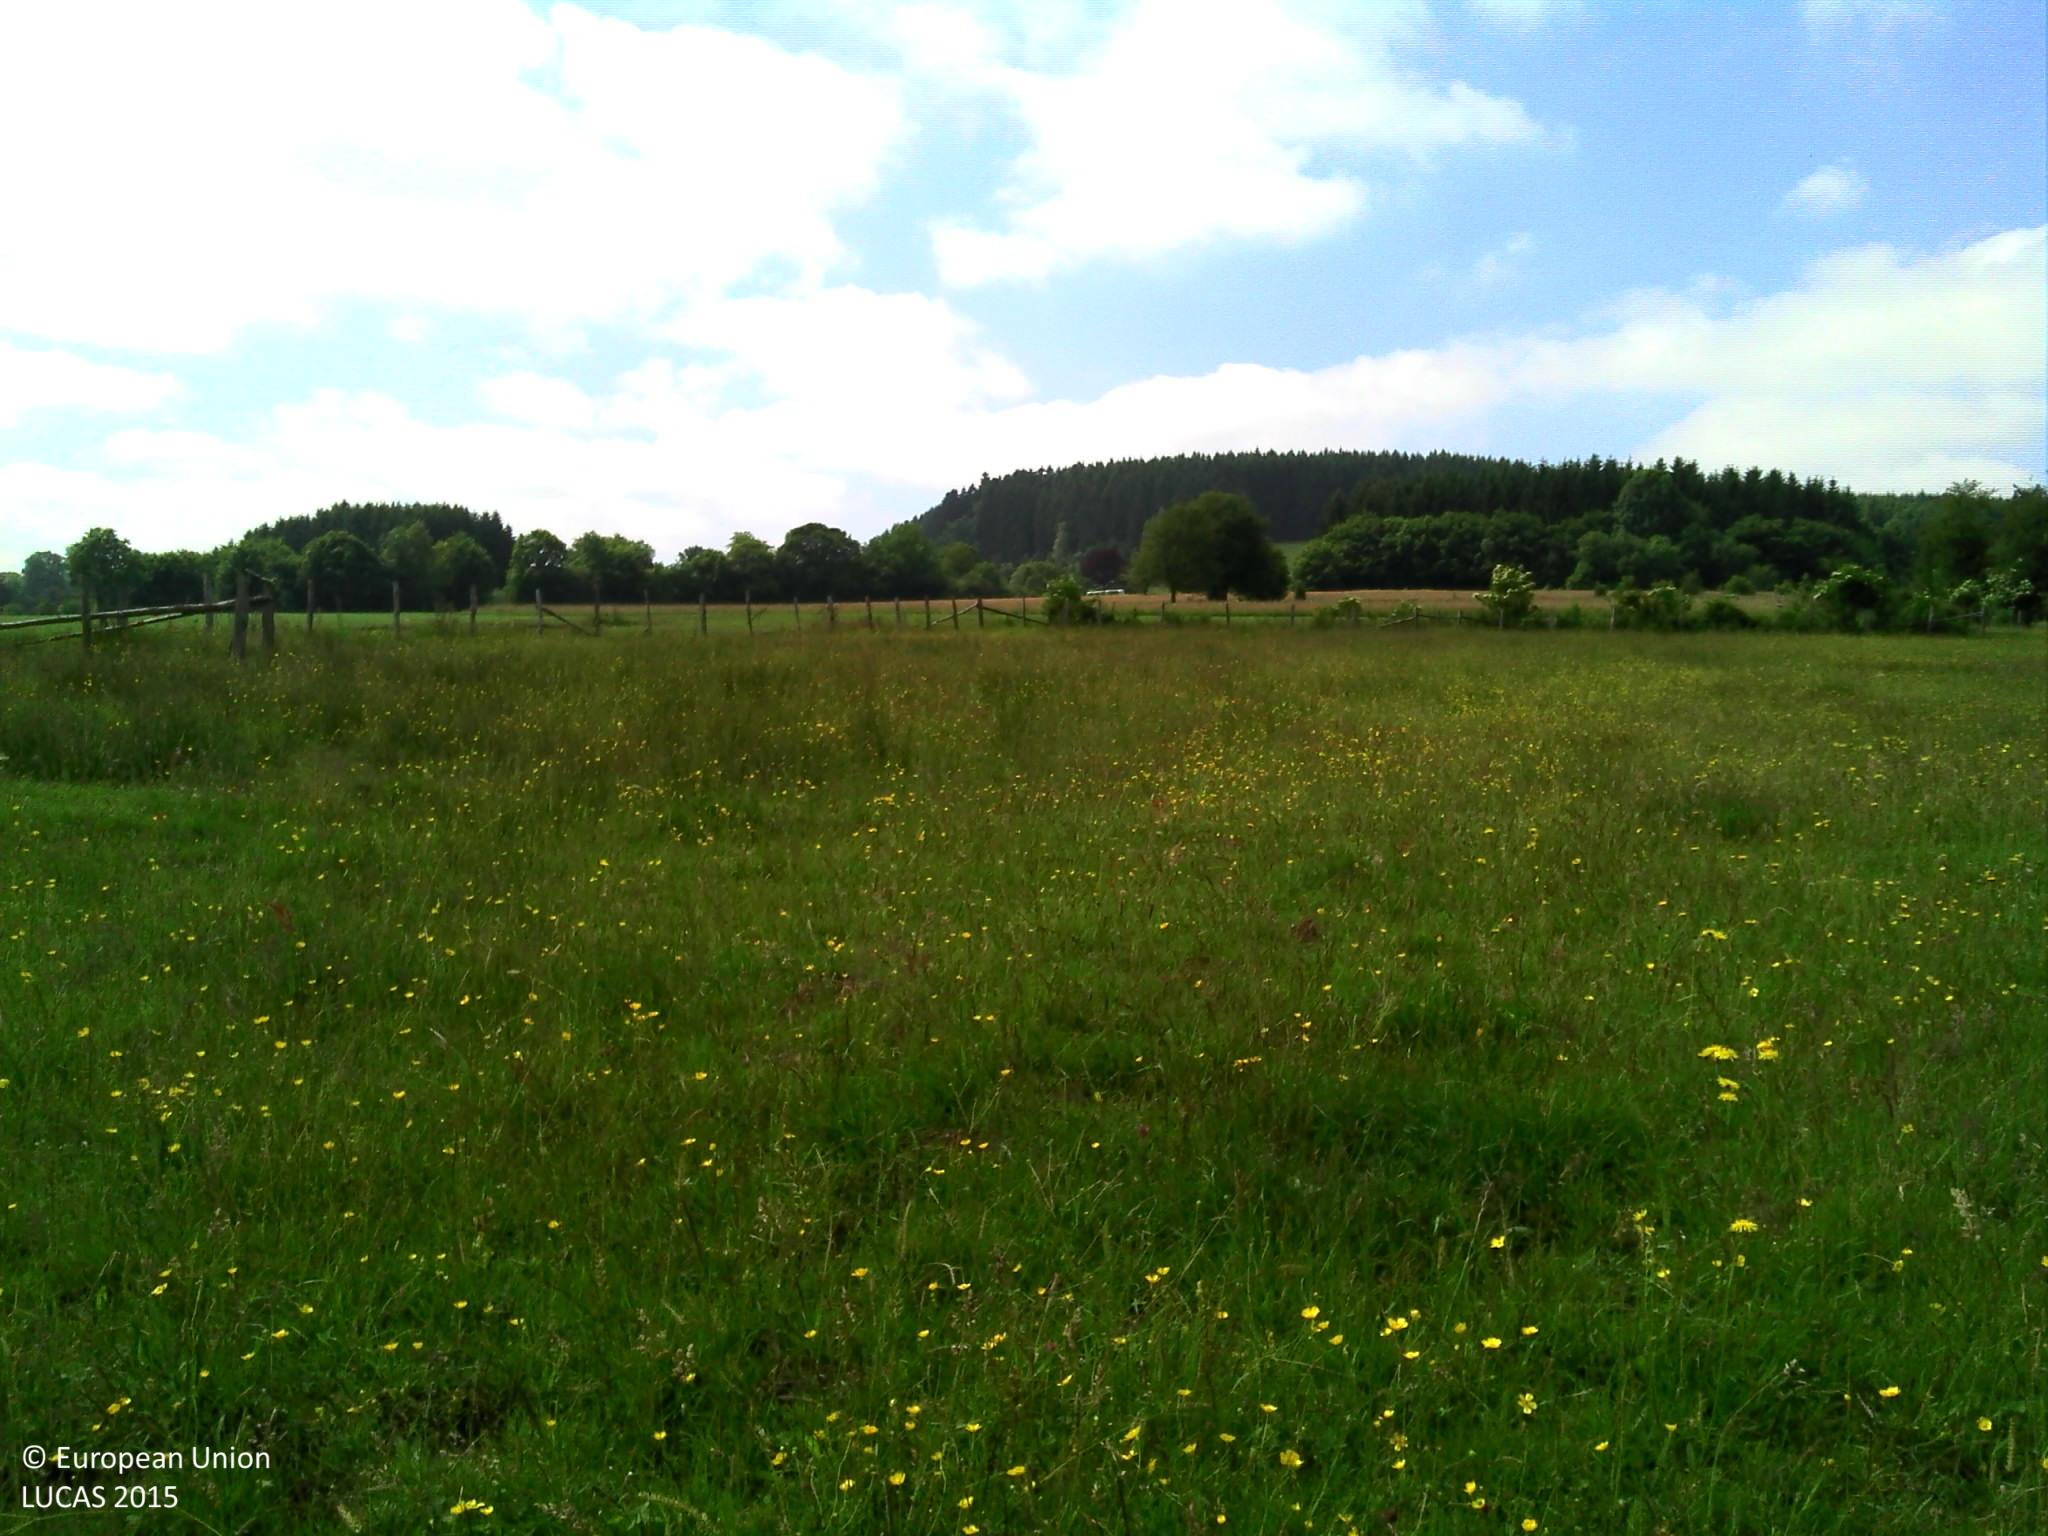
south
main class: Grassland
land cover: Grassland without tree/shrub cover
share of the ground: > 75 %
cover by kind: herbaceous plants 95 %, unconsolidated bare surface 5 %
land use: Agriculture (excluding fallow land and kitchen gardens)
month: June
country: BE
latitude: 50.2628
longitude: 5.6358
